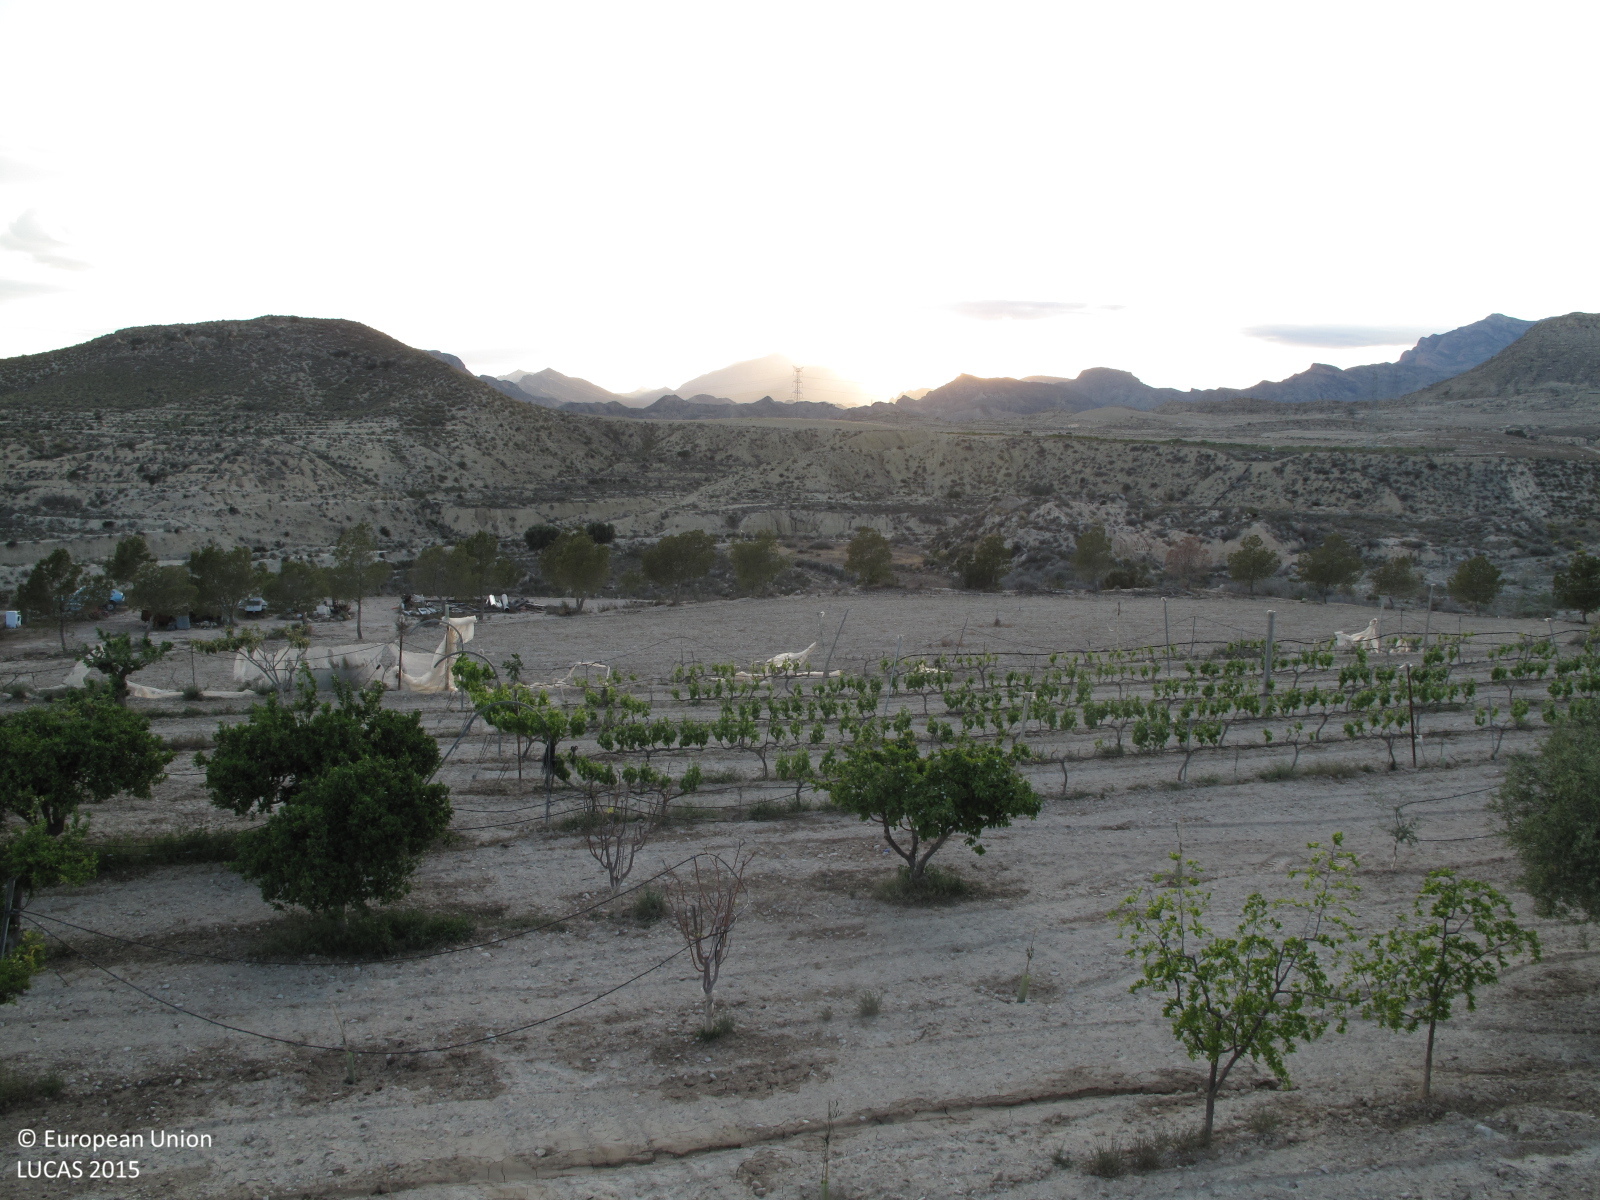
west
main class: Cropland
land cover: Olive groves
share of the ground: 10 - 25 %
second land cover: Other bare soil
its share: > 75 %
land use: Agriculture (excluding fallow land and kitchen gardens)
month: April
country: ES
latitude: 38.4850
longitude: -0.4535
